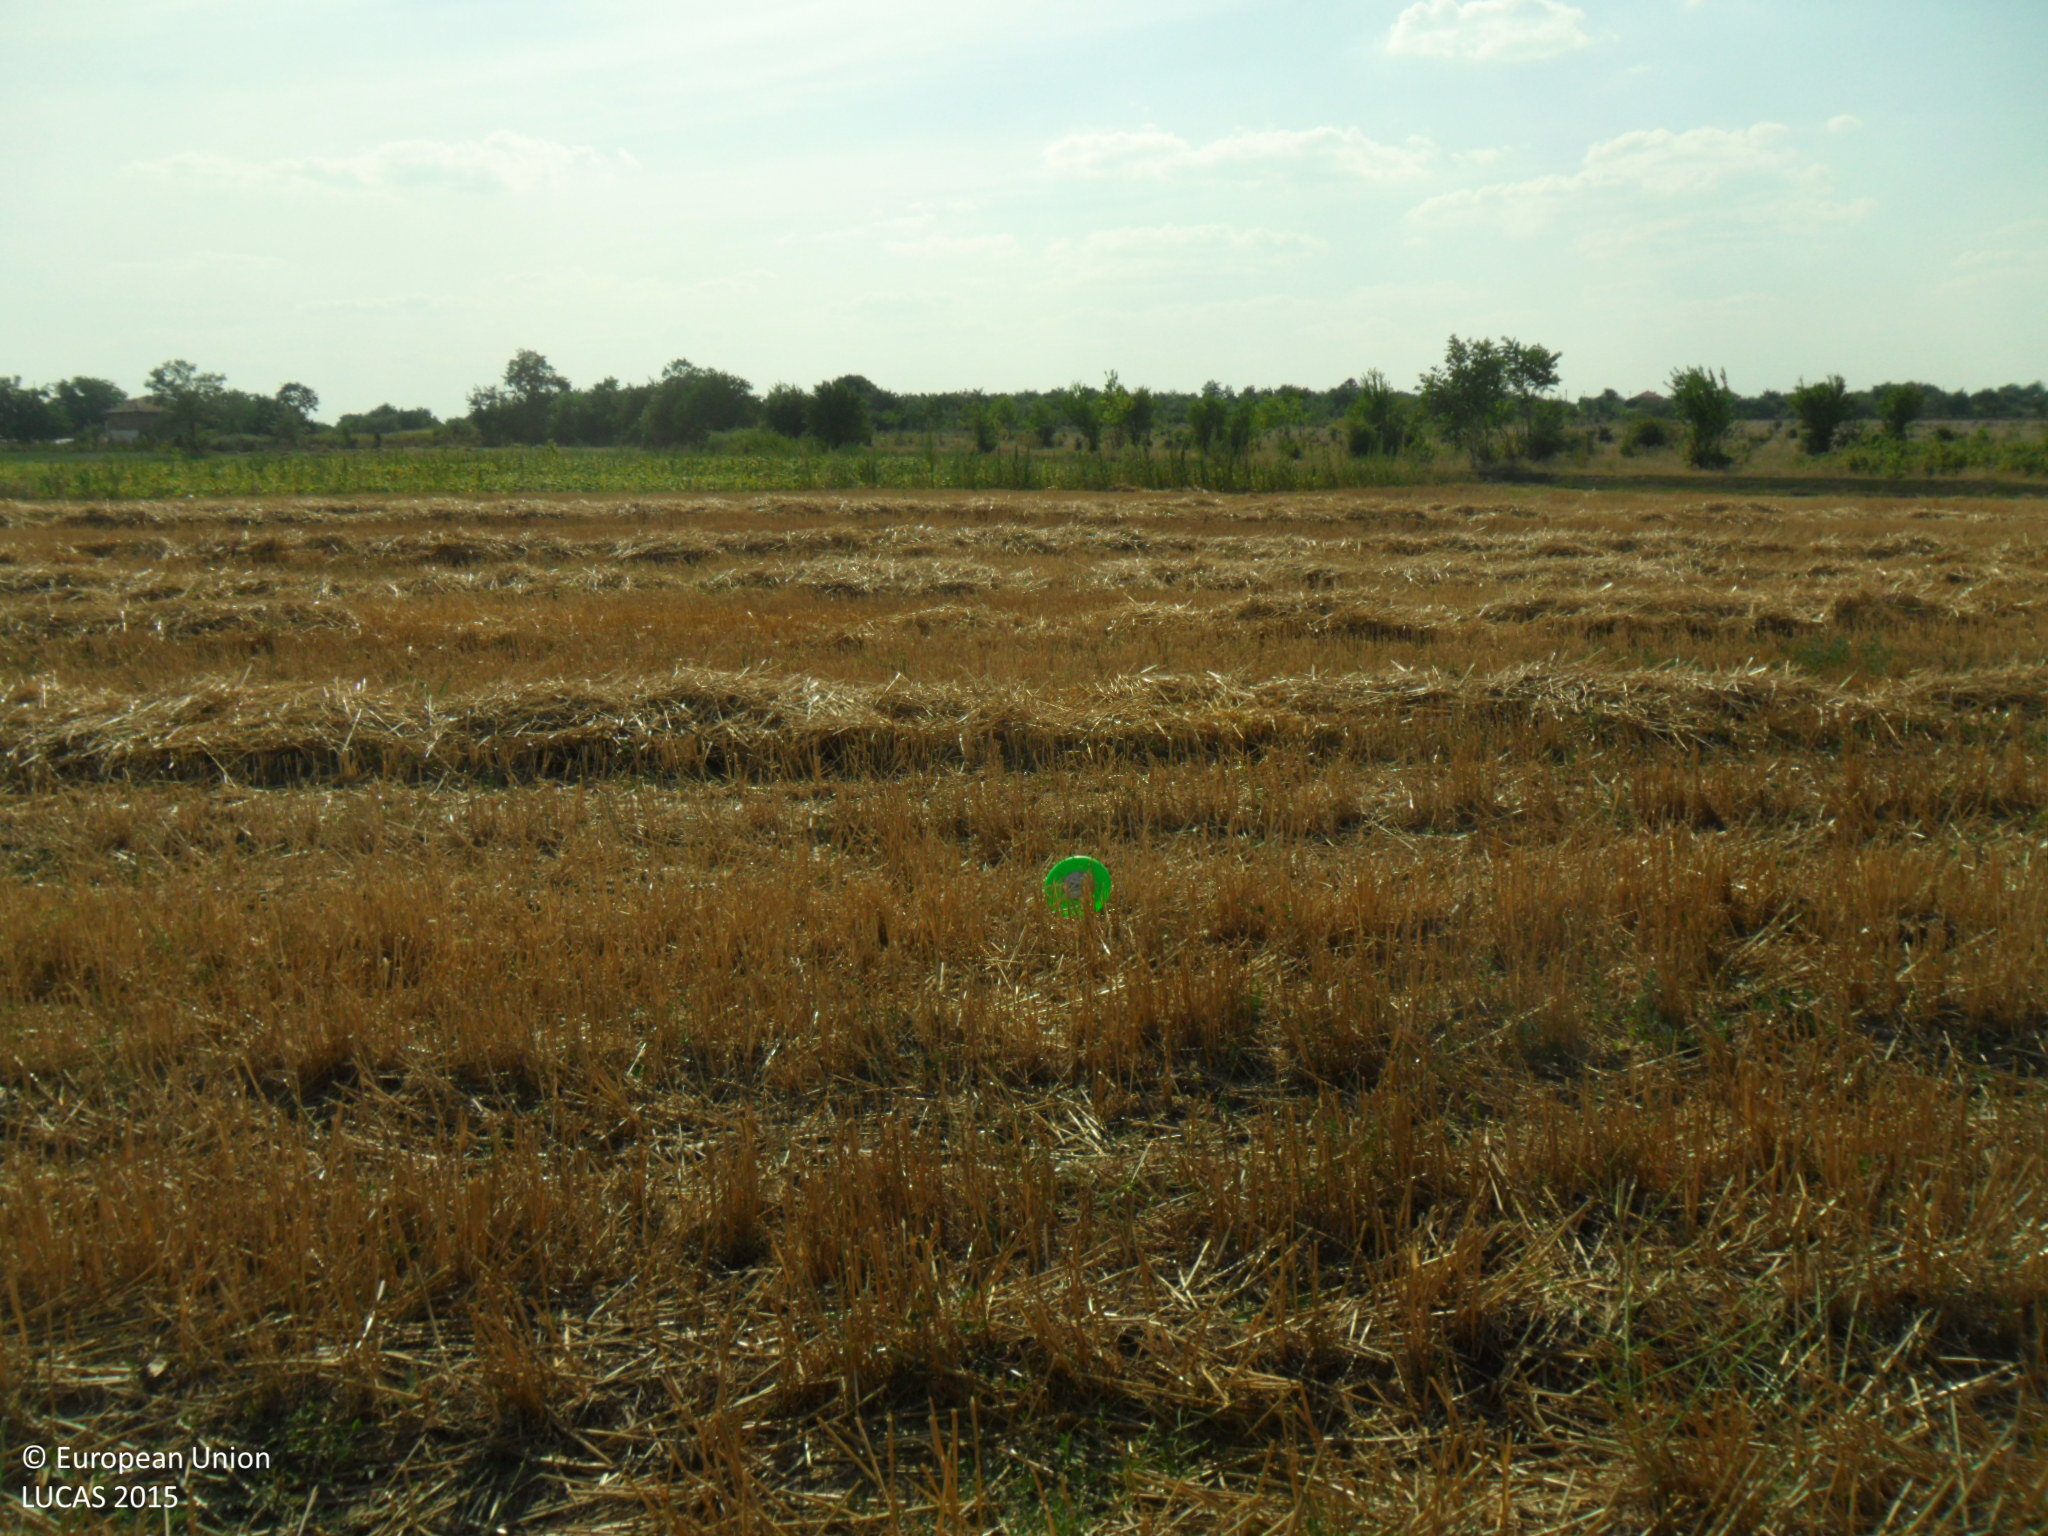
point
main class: Cropland
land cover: Common wheat
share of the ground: 25 - 50 %
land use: Agriculture (excluding fallow land and kitchen gardens)
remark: Harvested field
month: August
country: BG
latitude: 43.6428
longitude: 27.1692
